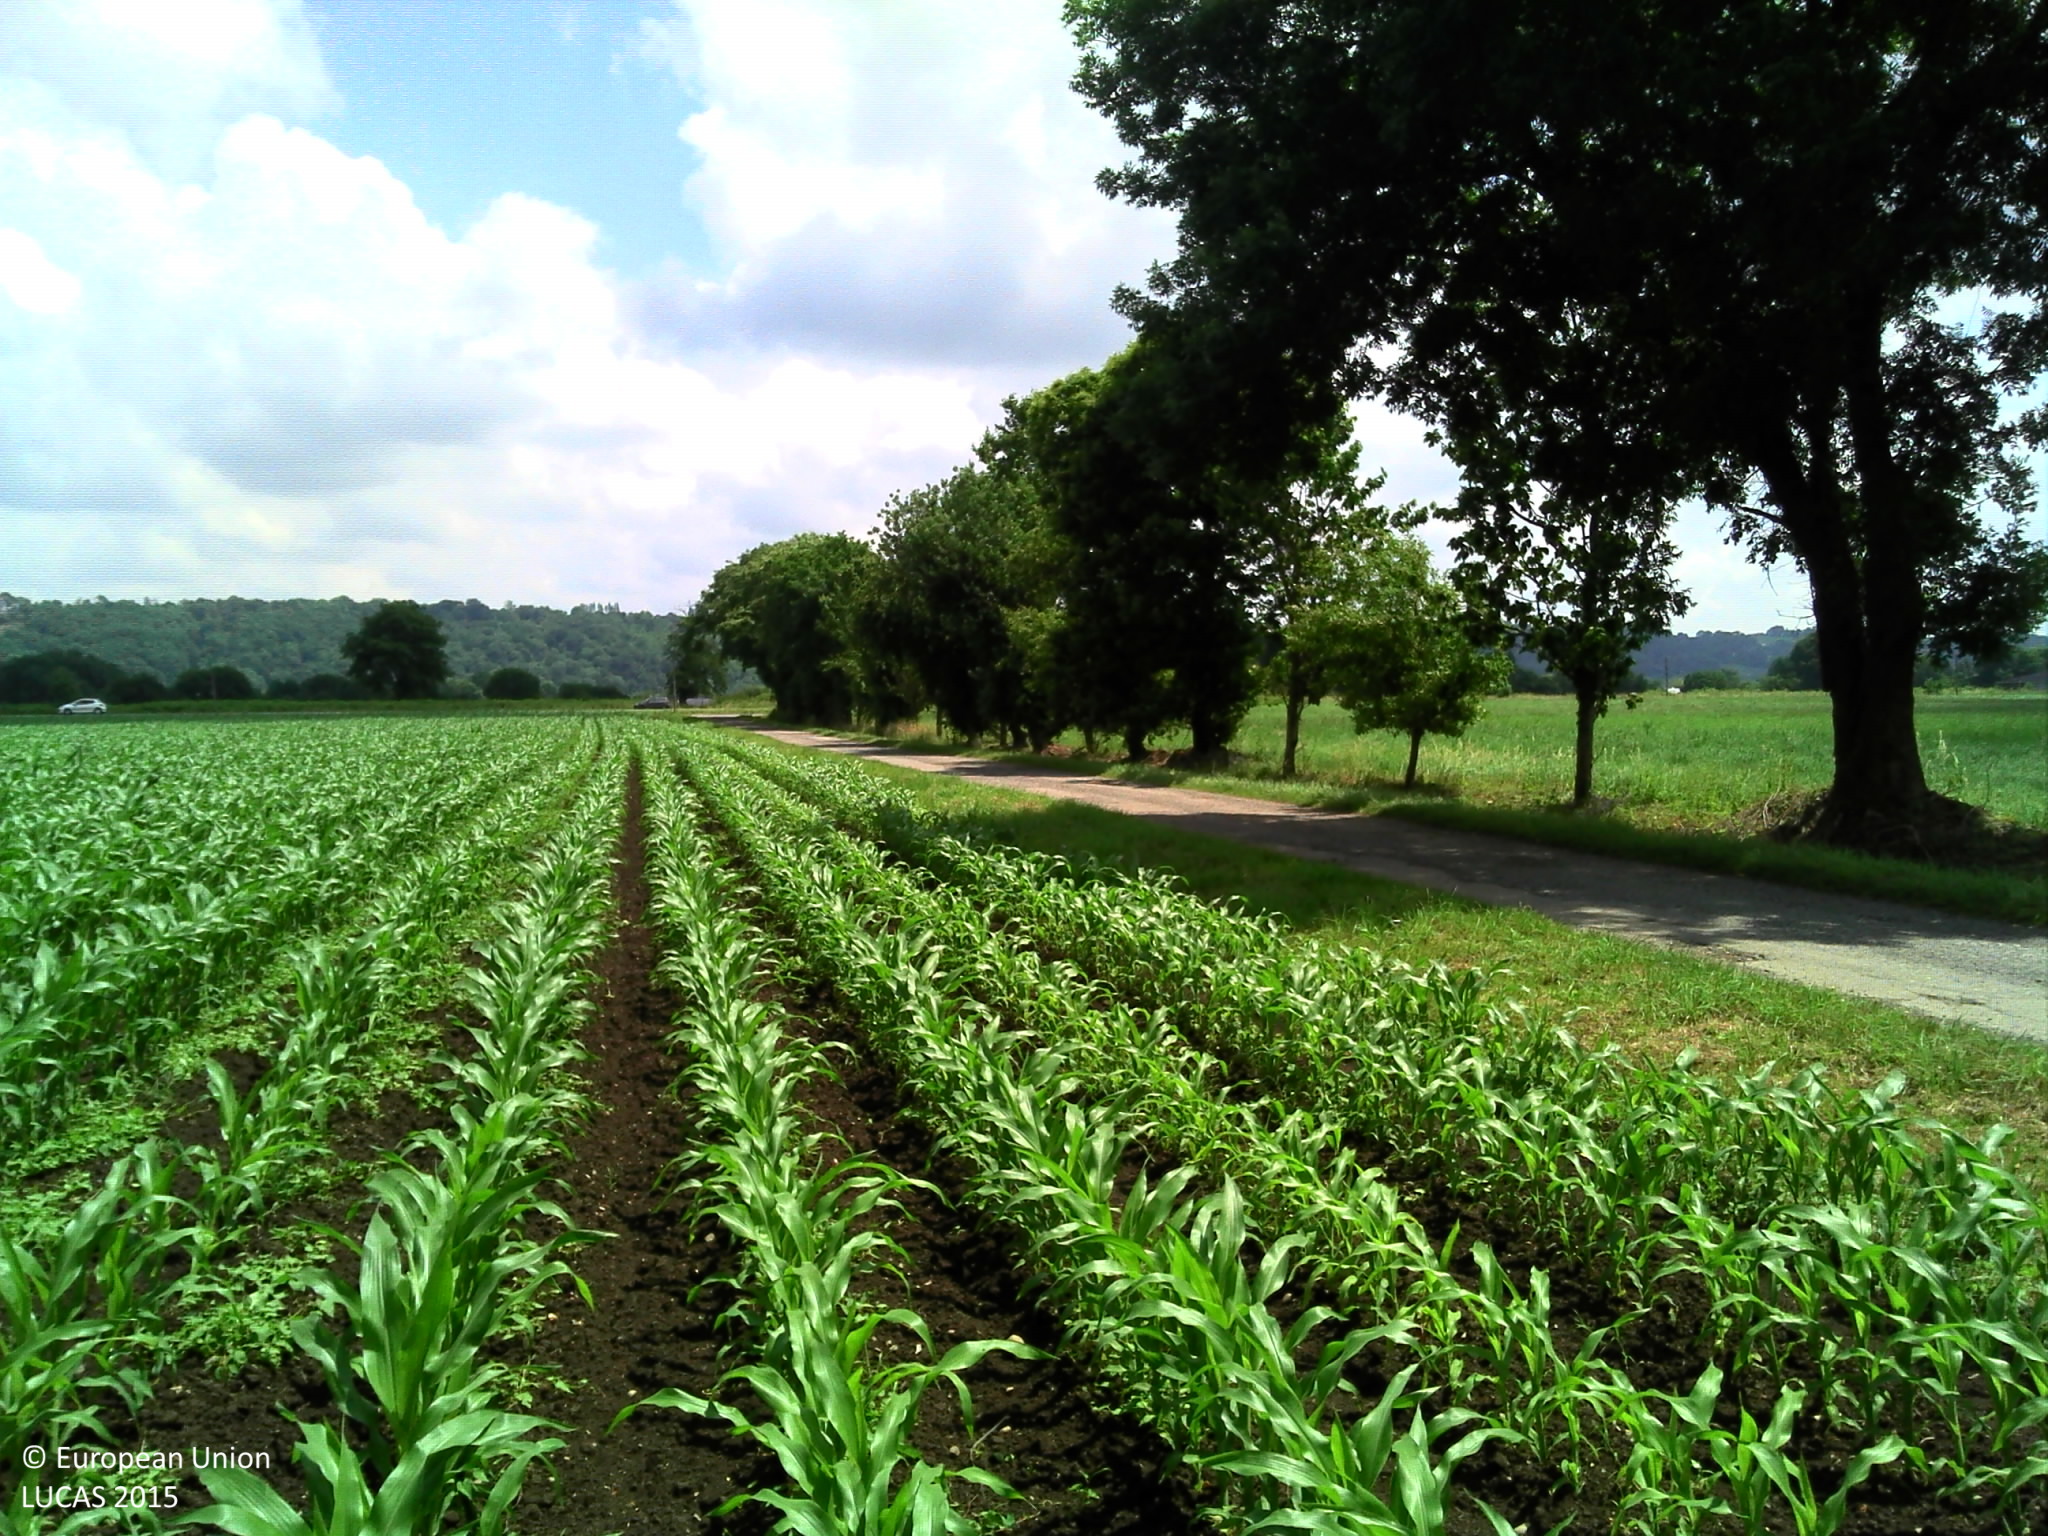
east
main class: Cropland
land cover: Maize
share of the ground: 25 - 50 %
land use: Agriculture (excluding fallow land and kitchen gardens)
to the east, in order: Maize; Grass margins; Paved roads, cycling and walking lanes; Grass margins; Ditches and canals; Lines of trees; Temporary grasslands; Grass margins; Paved roads, cycling and walking lanes; Grass margins; Electric lines; Ditches and canals; Grass margins; Paved roads, cycling and walking lanes; Grass margins; Ditches and canals; Shrubland without tree cover; Ditches and canals; Grass margins; Tracks; Grass margins; Ditches and canals; Maize
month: June
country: FR
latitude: 43.1992
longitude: -0.1326
